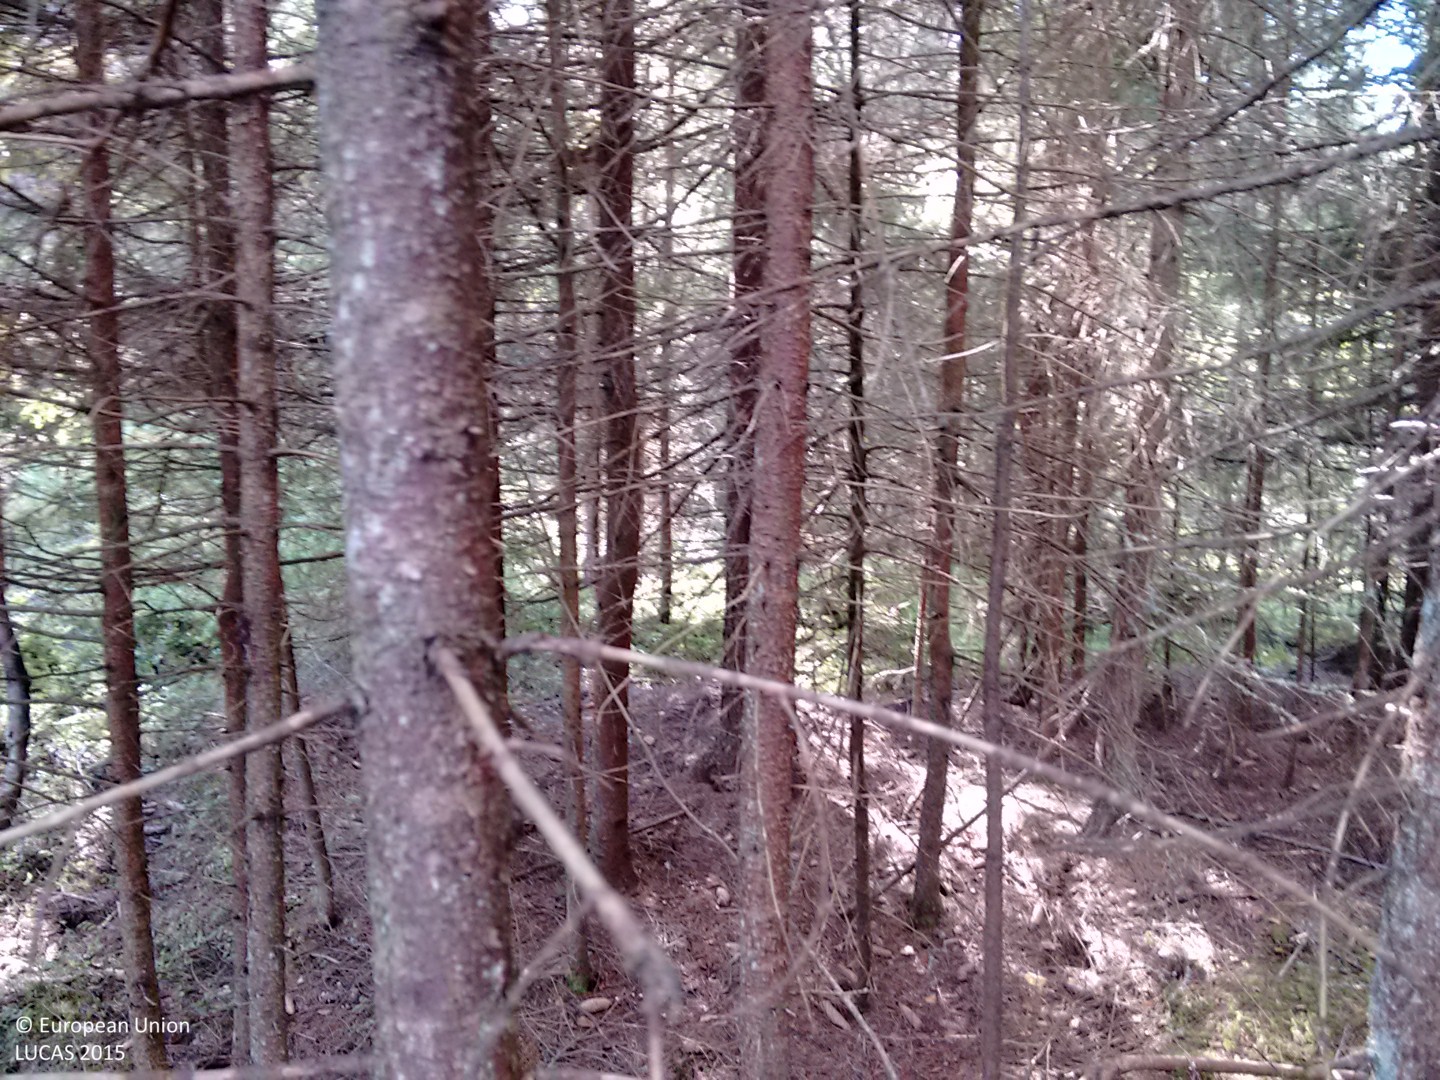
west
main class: Woodland
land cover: Spruce dominated coniferous woodland
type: hemiboreal forest and nemoral coniferous forest and mixed broadleaved-coniferous forest
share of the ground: > 75 %
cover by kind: coniferous forest trees 100 %
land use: Forestry
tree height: > 5 m
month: September
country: FI
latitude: 61.0497
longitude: 21.3674
